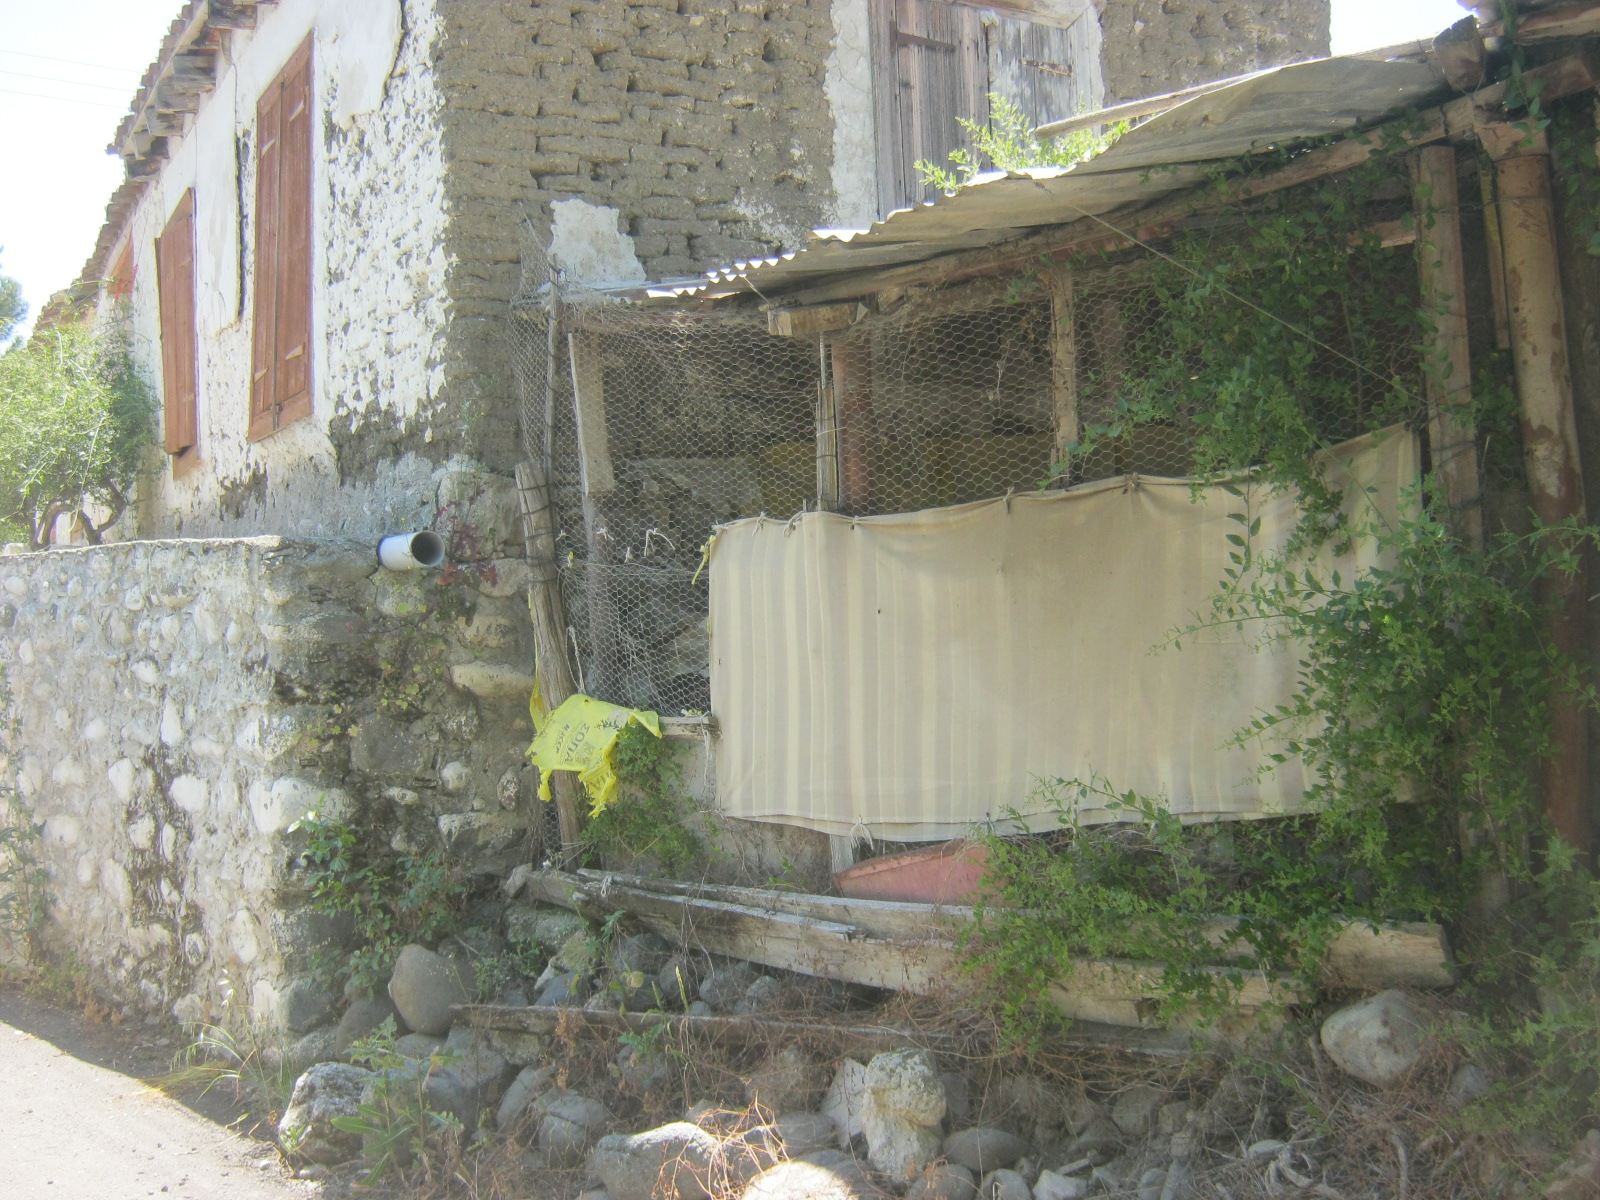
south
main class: Cropland
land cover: Other fruit trees and berries
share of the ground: > 75 %
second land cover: Other bare soil
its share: > 75 %
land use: Agriculture (excluding fallow land and kitchen gardens)
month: May
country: CY
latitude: 35.0852
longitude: 32.8873
